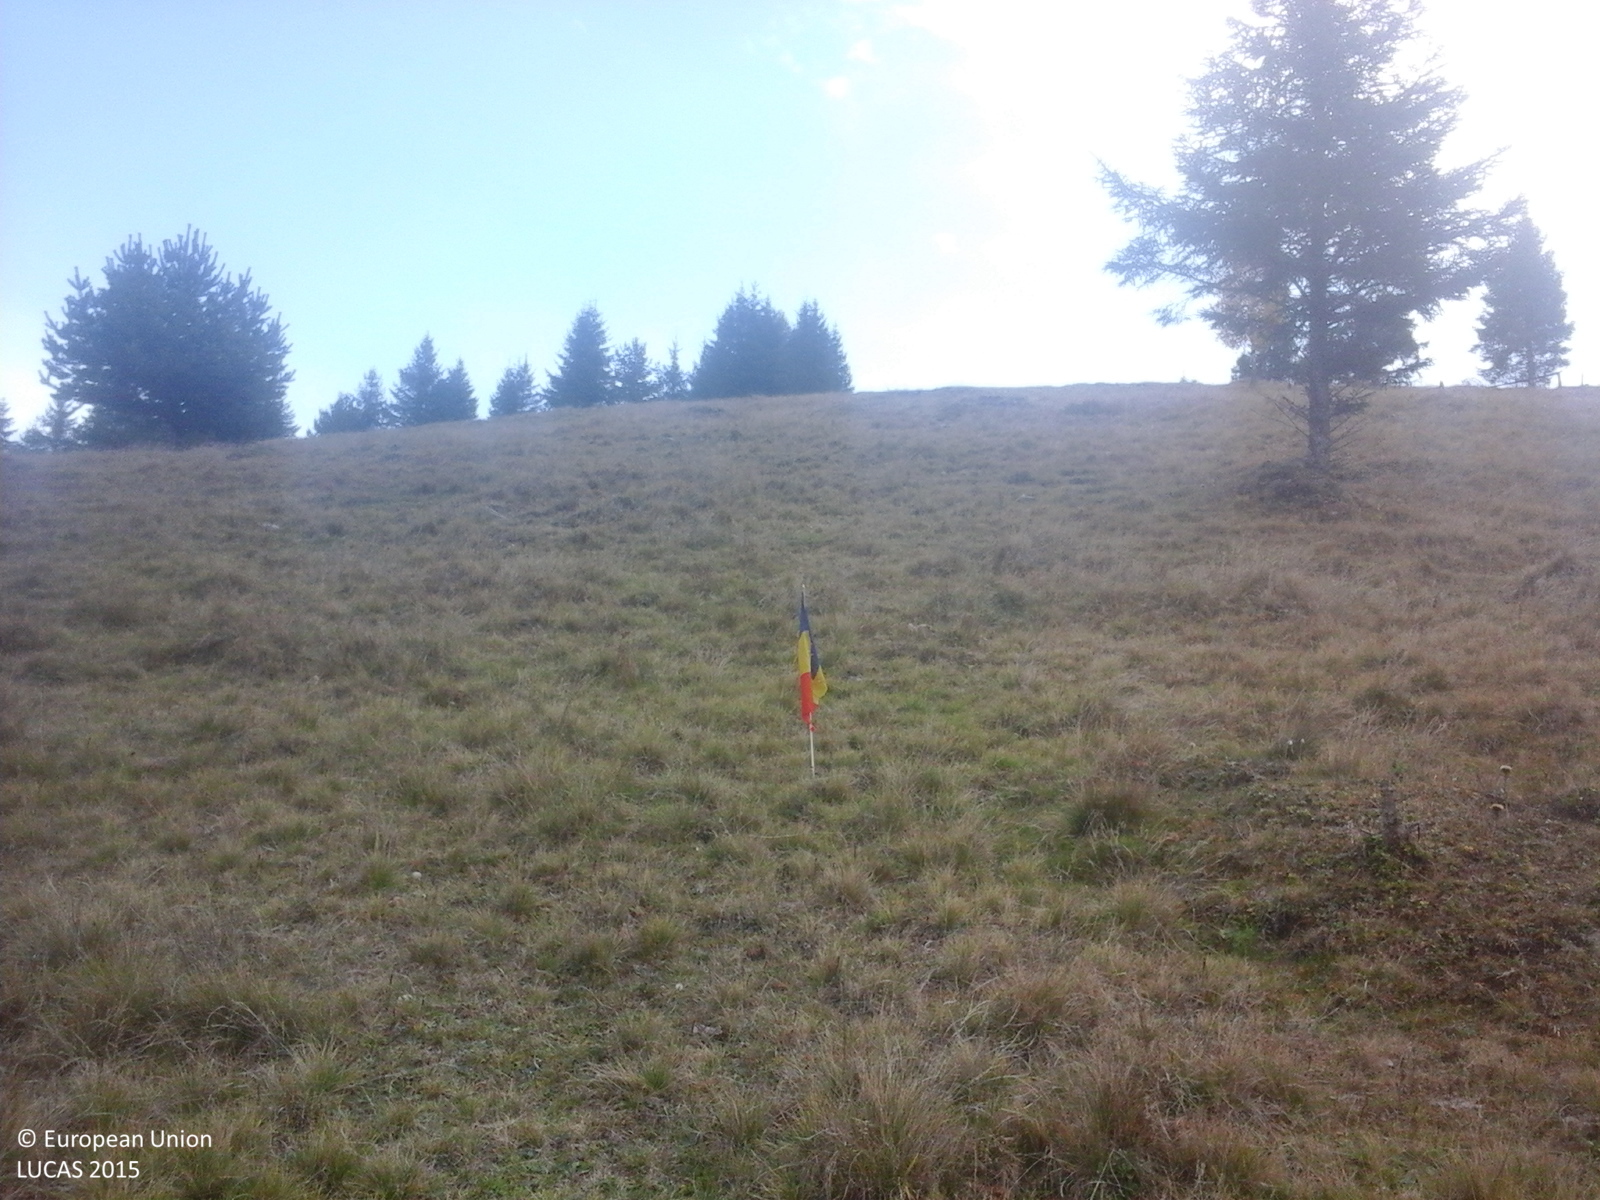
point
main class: Grassland
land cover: Grassland with sparse tree/shrub cover
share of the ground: > 75 %
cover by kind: herbaceous plants 85 %, shrubs 10 %, coniferous forest trees 5 %
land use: Forestry
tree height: > 5 m
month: October
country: RO
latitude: 46.3169
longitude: 26.0824
